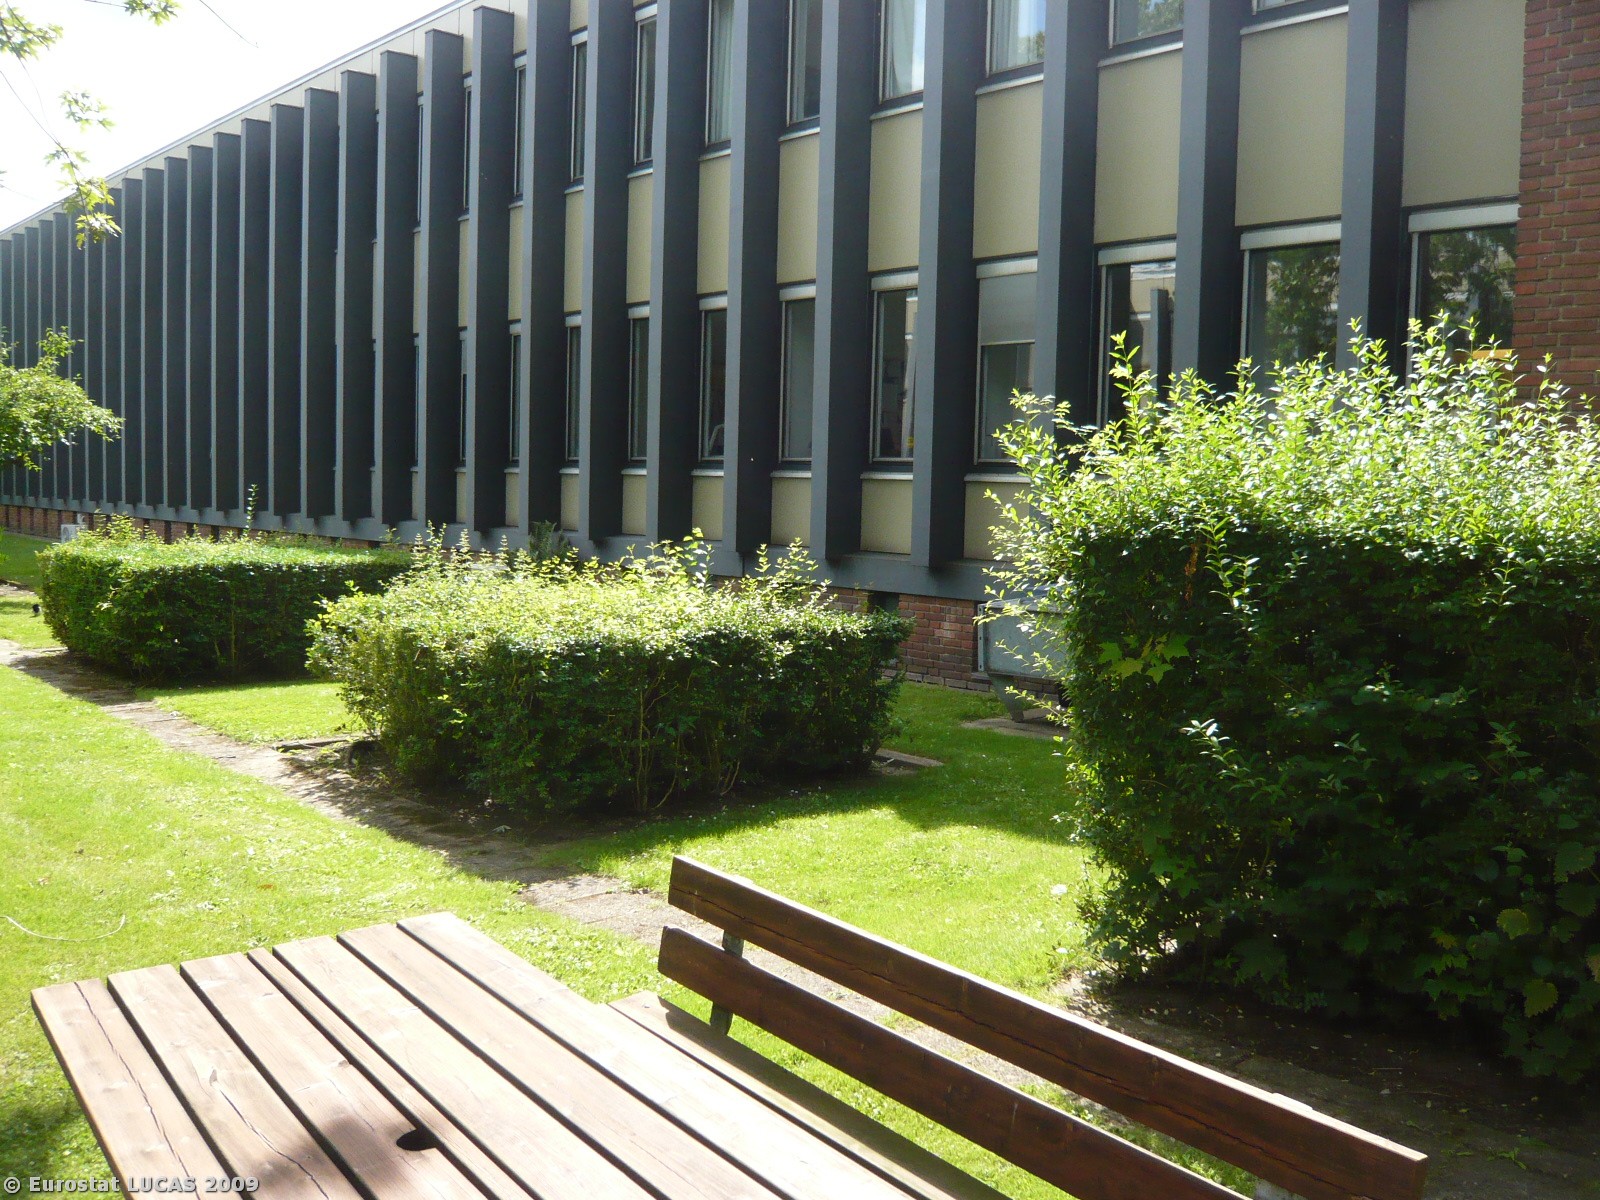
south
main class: Grassland
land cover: Grassland without tree/shrub cover
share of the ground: > 75 %
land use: Community services
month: July
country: DK
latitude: 55.9325
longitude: 12.3509
